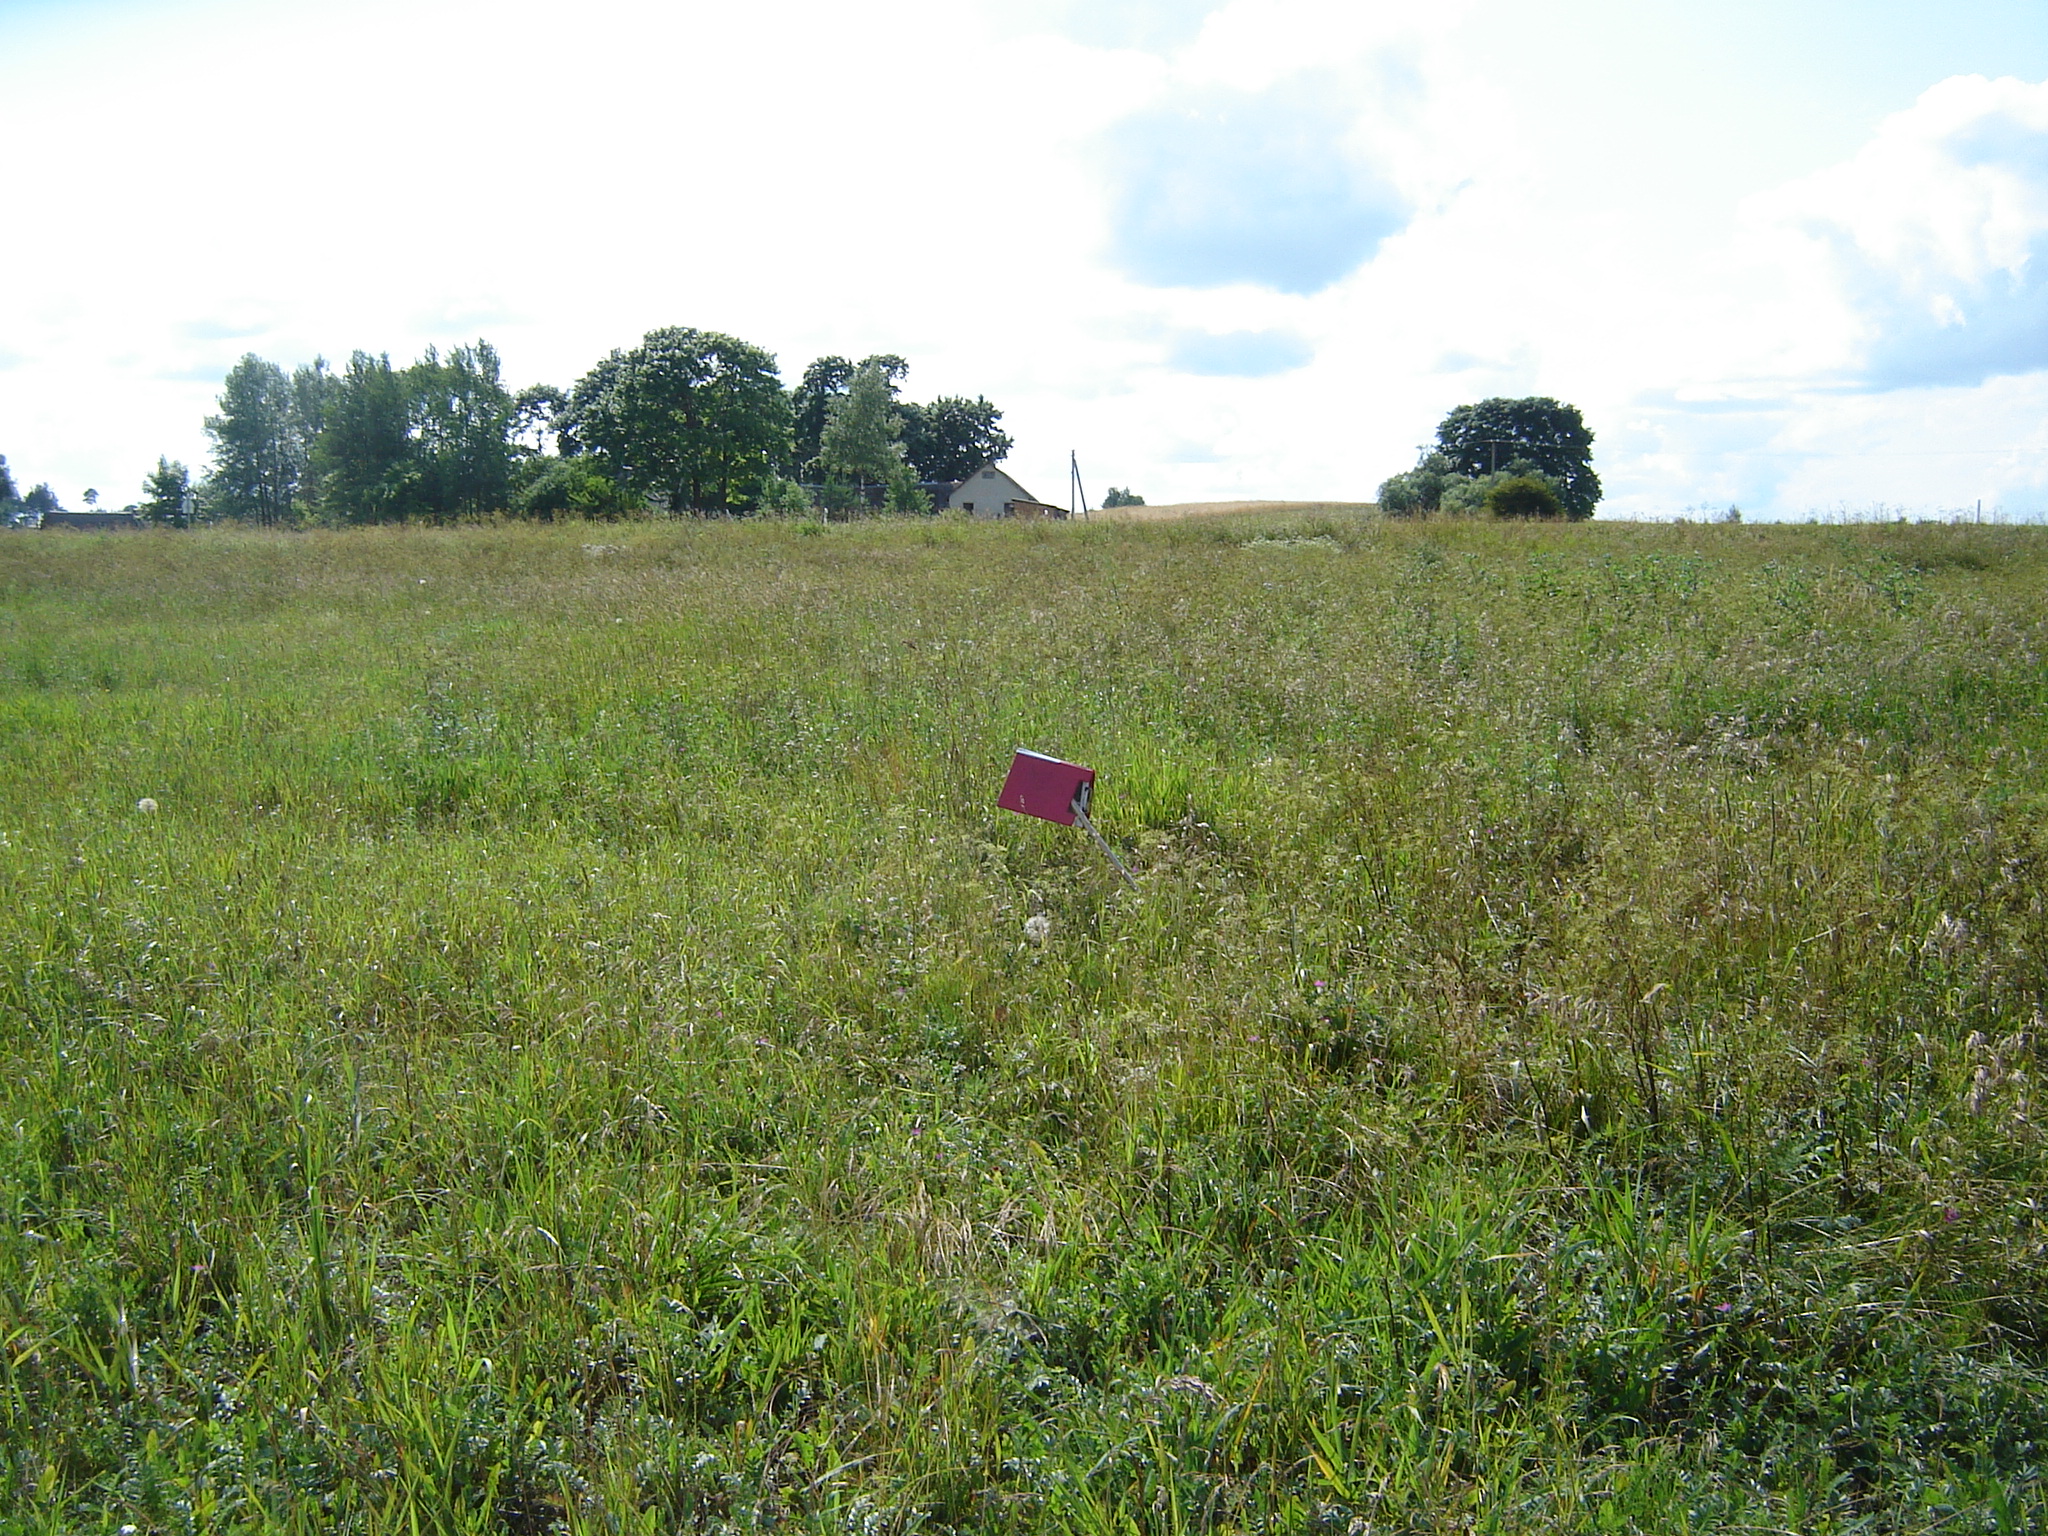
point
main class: Grassland
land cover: Grassland without tree/shrub cover
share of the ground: > 75 %
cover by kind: herbaceous plants 100 %
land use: Agriculture (excluding fallow land and kitchen gardens)
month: July
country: LT
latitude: 55.2425
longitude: 25.4591
